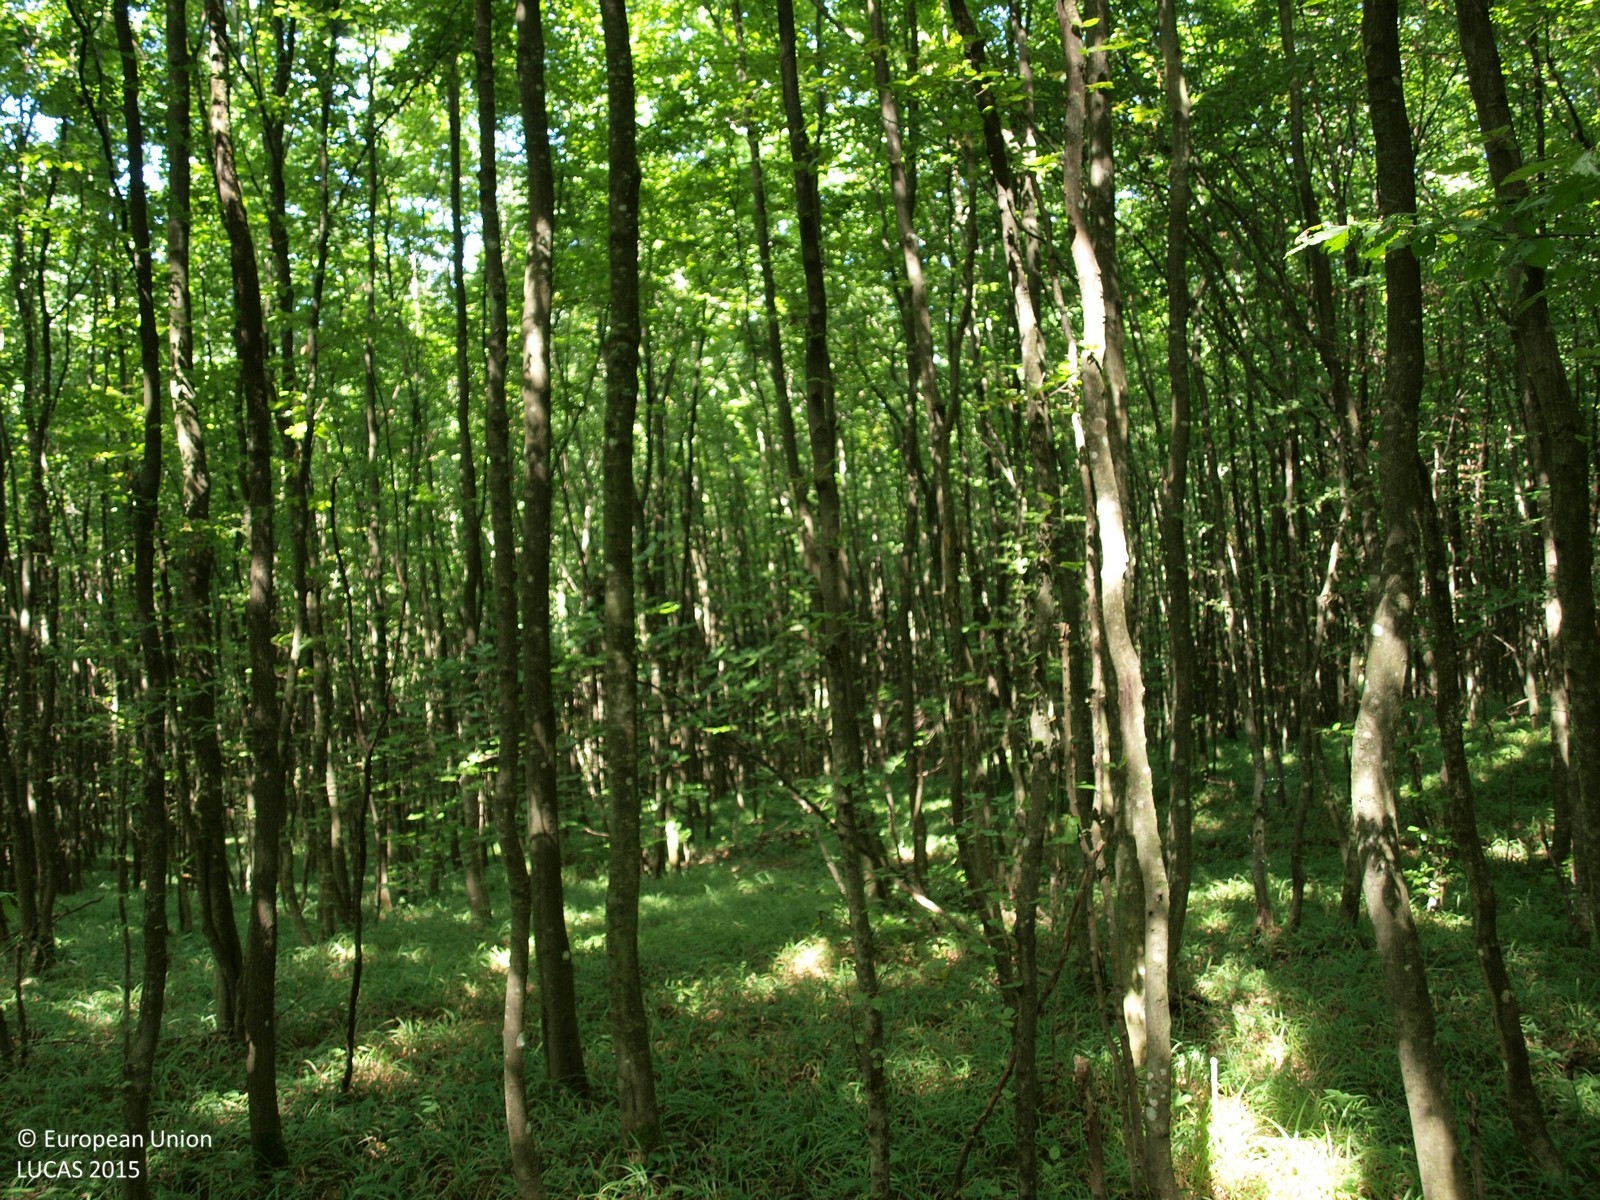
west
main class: Woodland
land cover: Broadleaved woodland
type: mesophytic deciduous forest
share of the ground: > 75 %
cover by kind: broadleaved forest trees 100 %
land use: Forestry
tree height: > 5 m
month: August
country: HR
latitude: 46.0154
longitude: 16.3929
